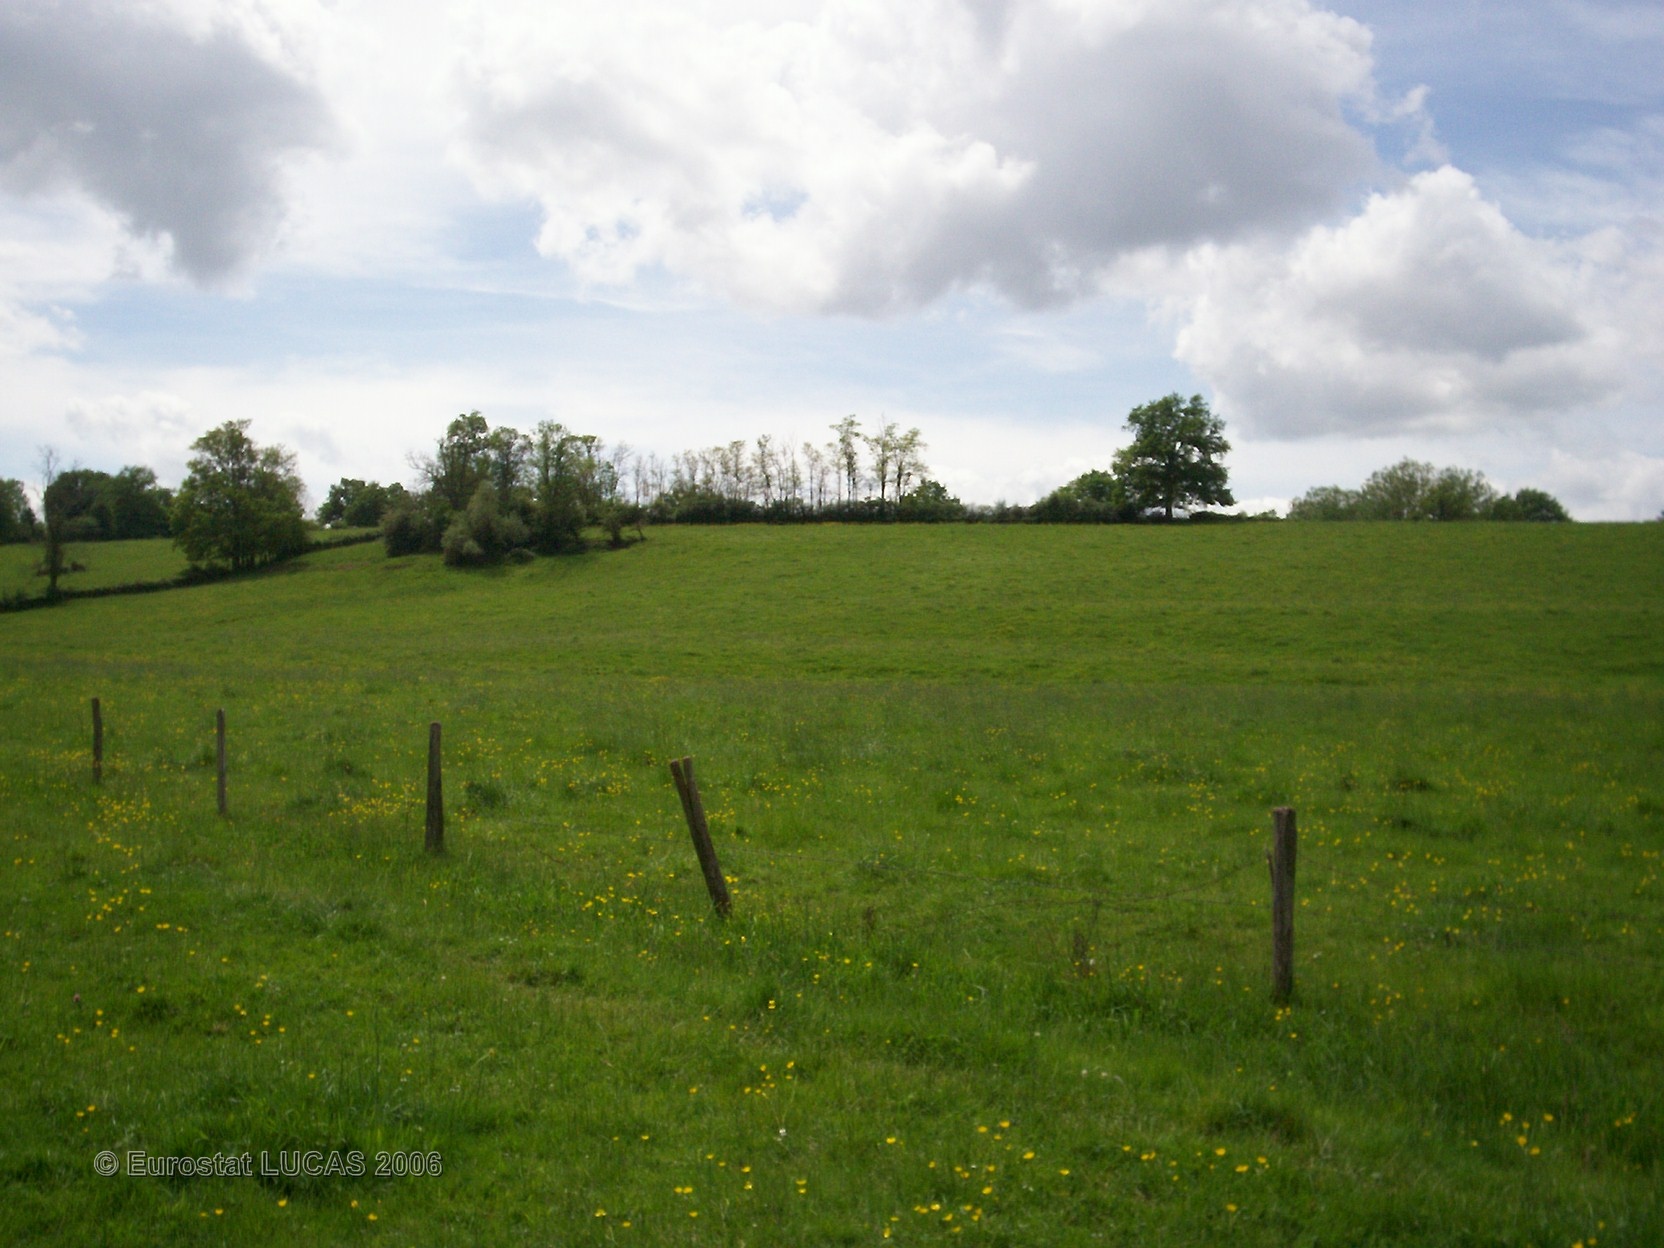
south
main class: Grassland
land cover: Grassland without tree/shrub cover
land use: Agriculture (excluding fallow land and kitchen gardens)
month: May
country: FR
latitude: 46.1183
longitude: 4.1397
